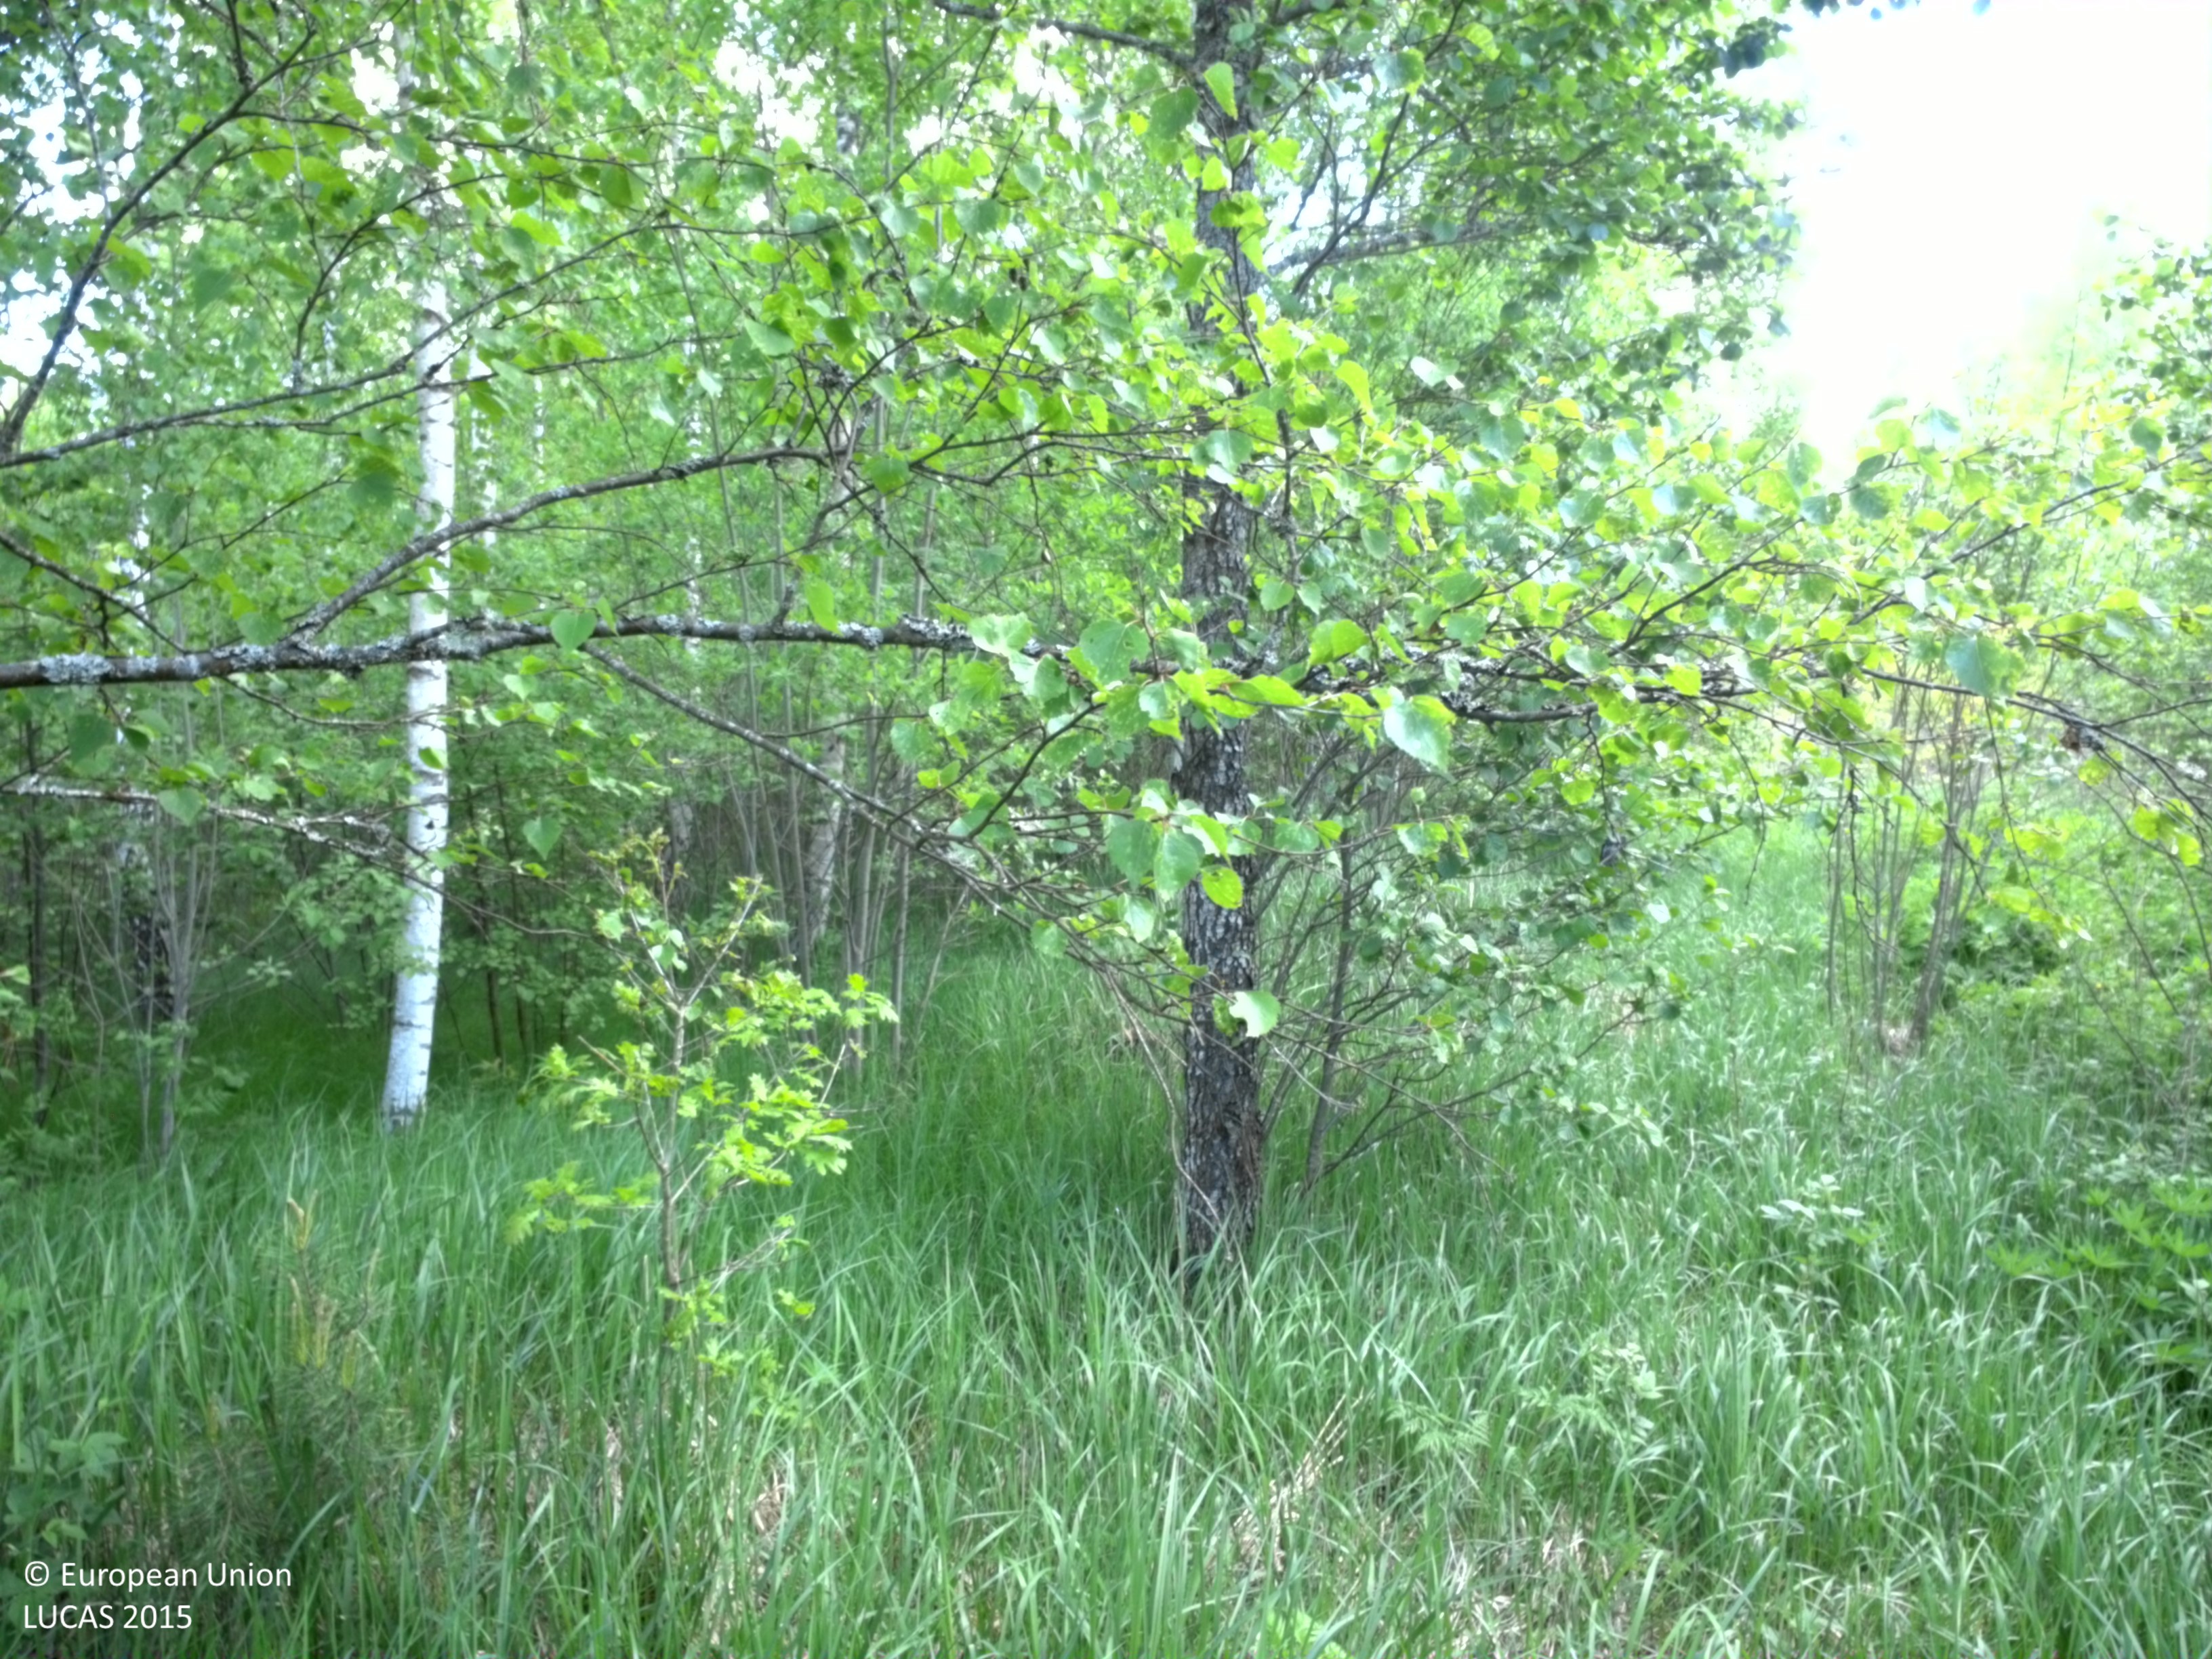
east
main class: Woodland
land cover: Broadleaved woodland
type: boreal forest
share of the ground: 50 - 75 %
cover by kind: broadleaved forest trees 50 %, herbaceous plants 30 %, shrubs 20 %
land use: Forestry
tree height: > 5 m
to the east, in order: Broadleaved woodland; Inland marshes; Inland fresh water bodies
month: May
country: SE
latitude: 57.3326
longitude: 15.8950
